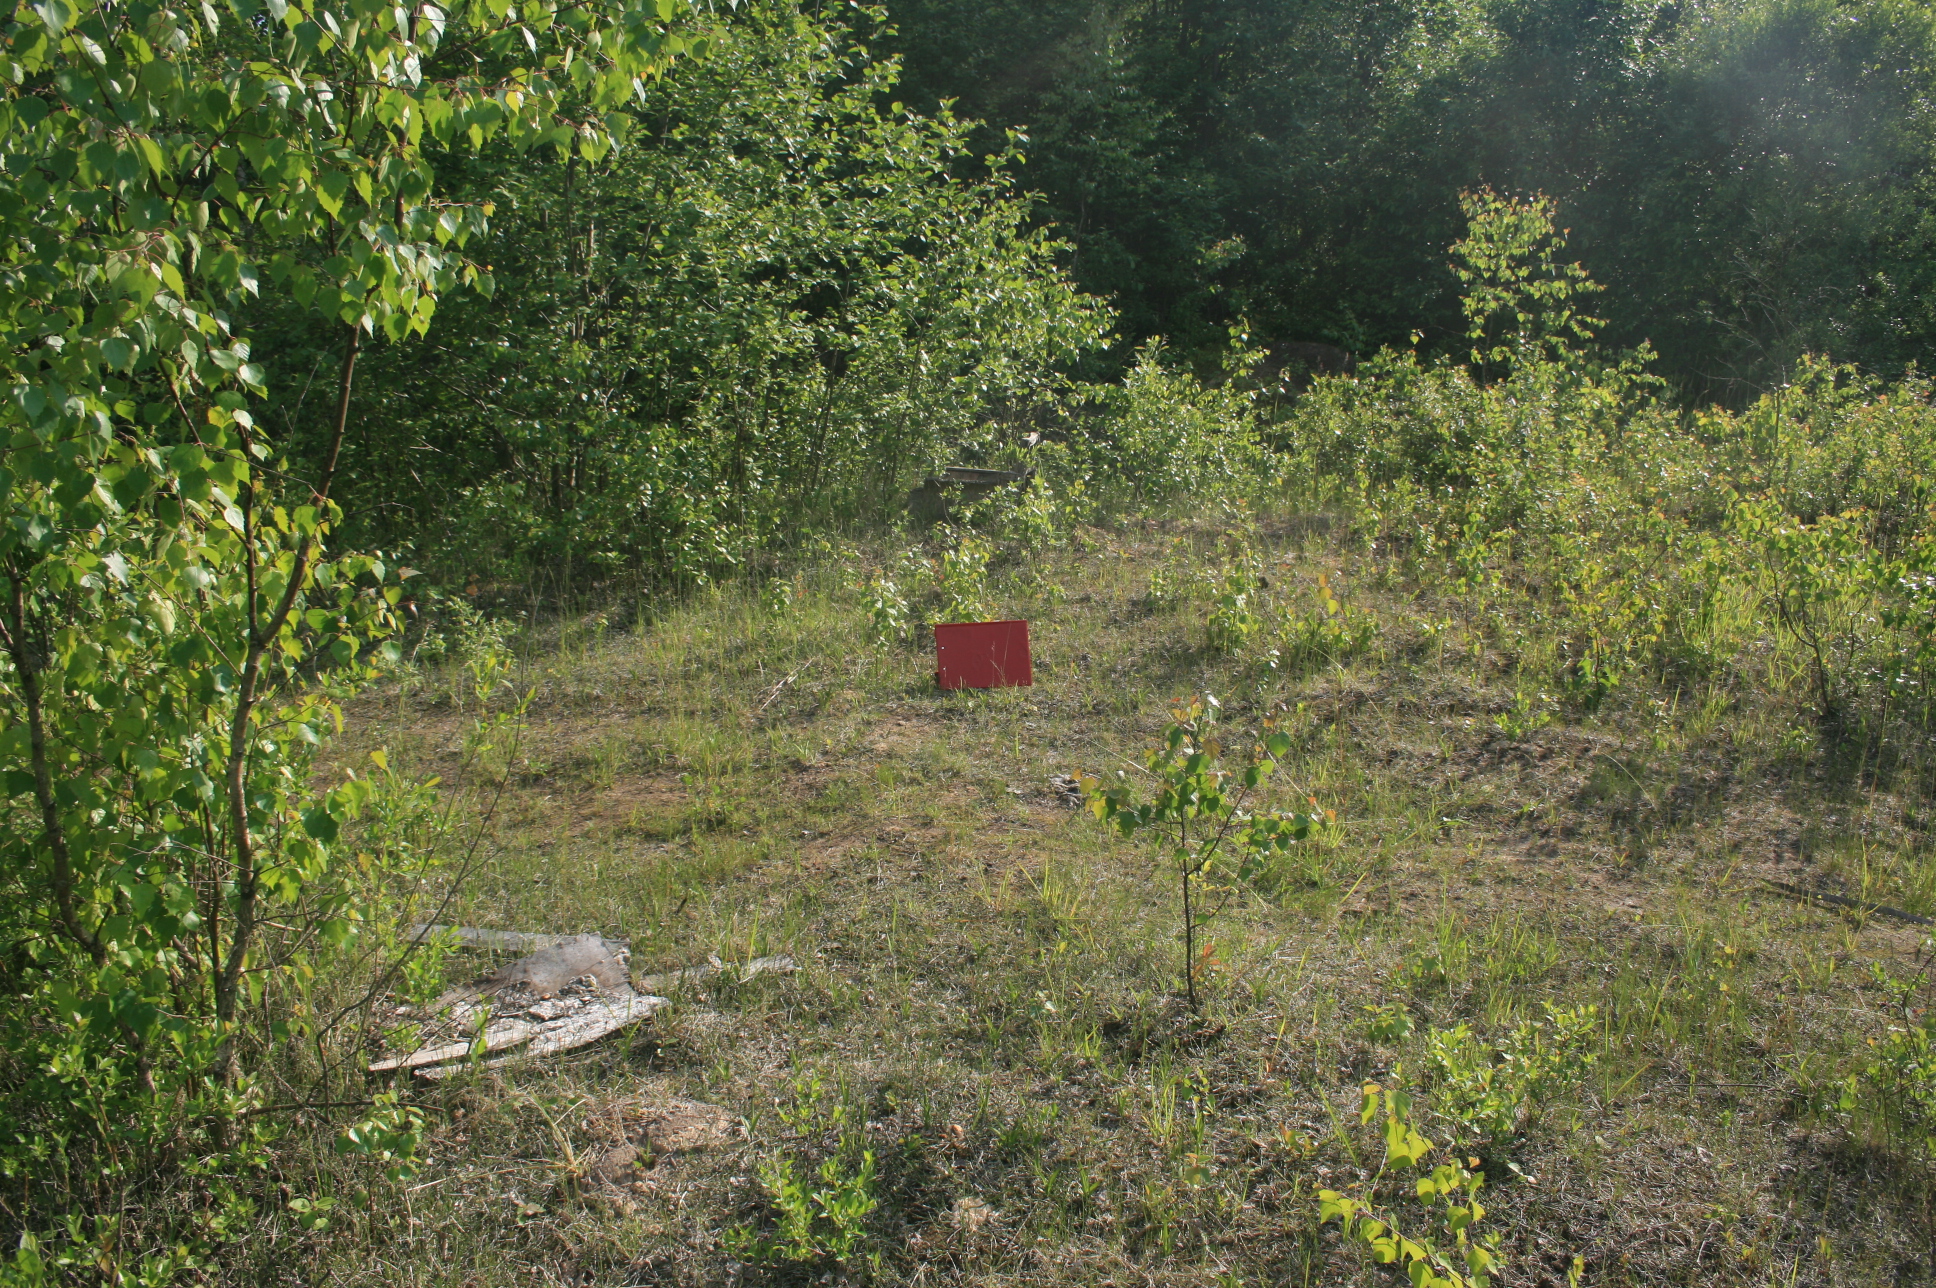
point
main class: Woodland
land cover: Broadleaved woodland
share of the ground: 50 - 75 %
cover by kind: broadleaved forest trees 60 %, herbaceous plants 25 %, unconsolidated bare surface 15 %
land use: Forestry
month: June
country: LT
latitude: 55.6385
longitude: 22.2091
